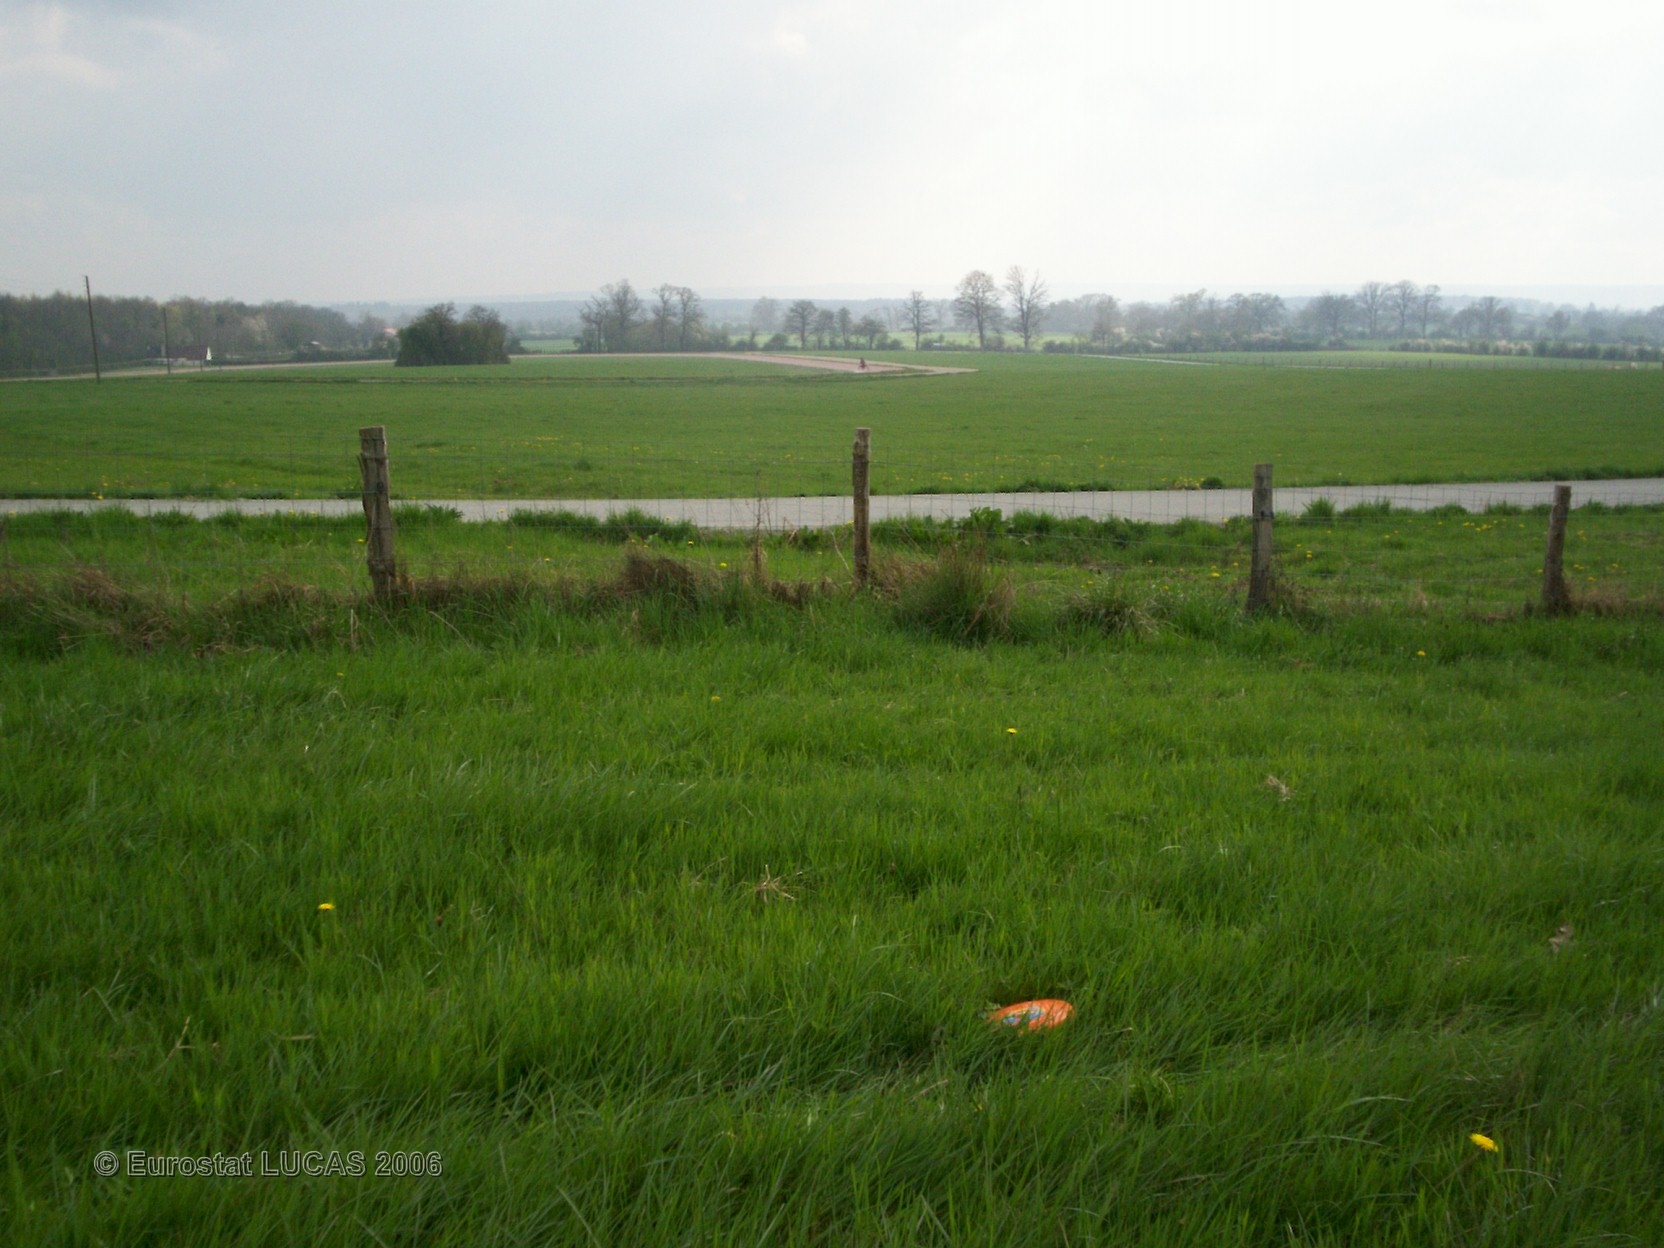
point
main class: Grassland
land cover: Grassland without tree/shrub cover
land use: Agriculture (excluding fallow land and kitchen gardens)
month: April
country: FR
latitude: 48.7055
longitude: 0.1467
